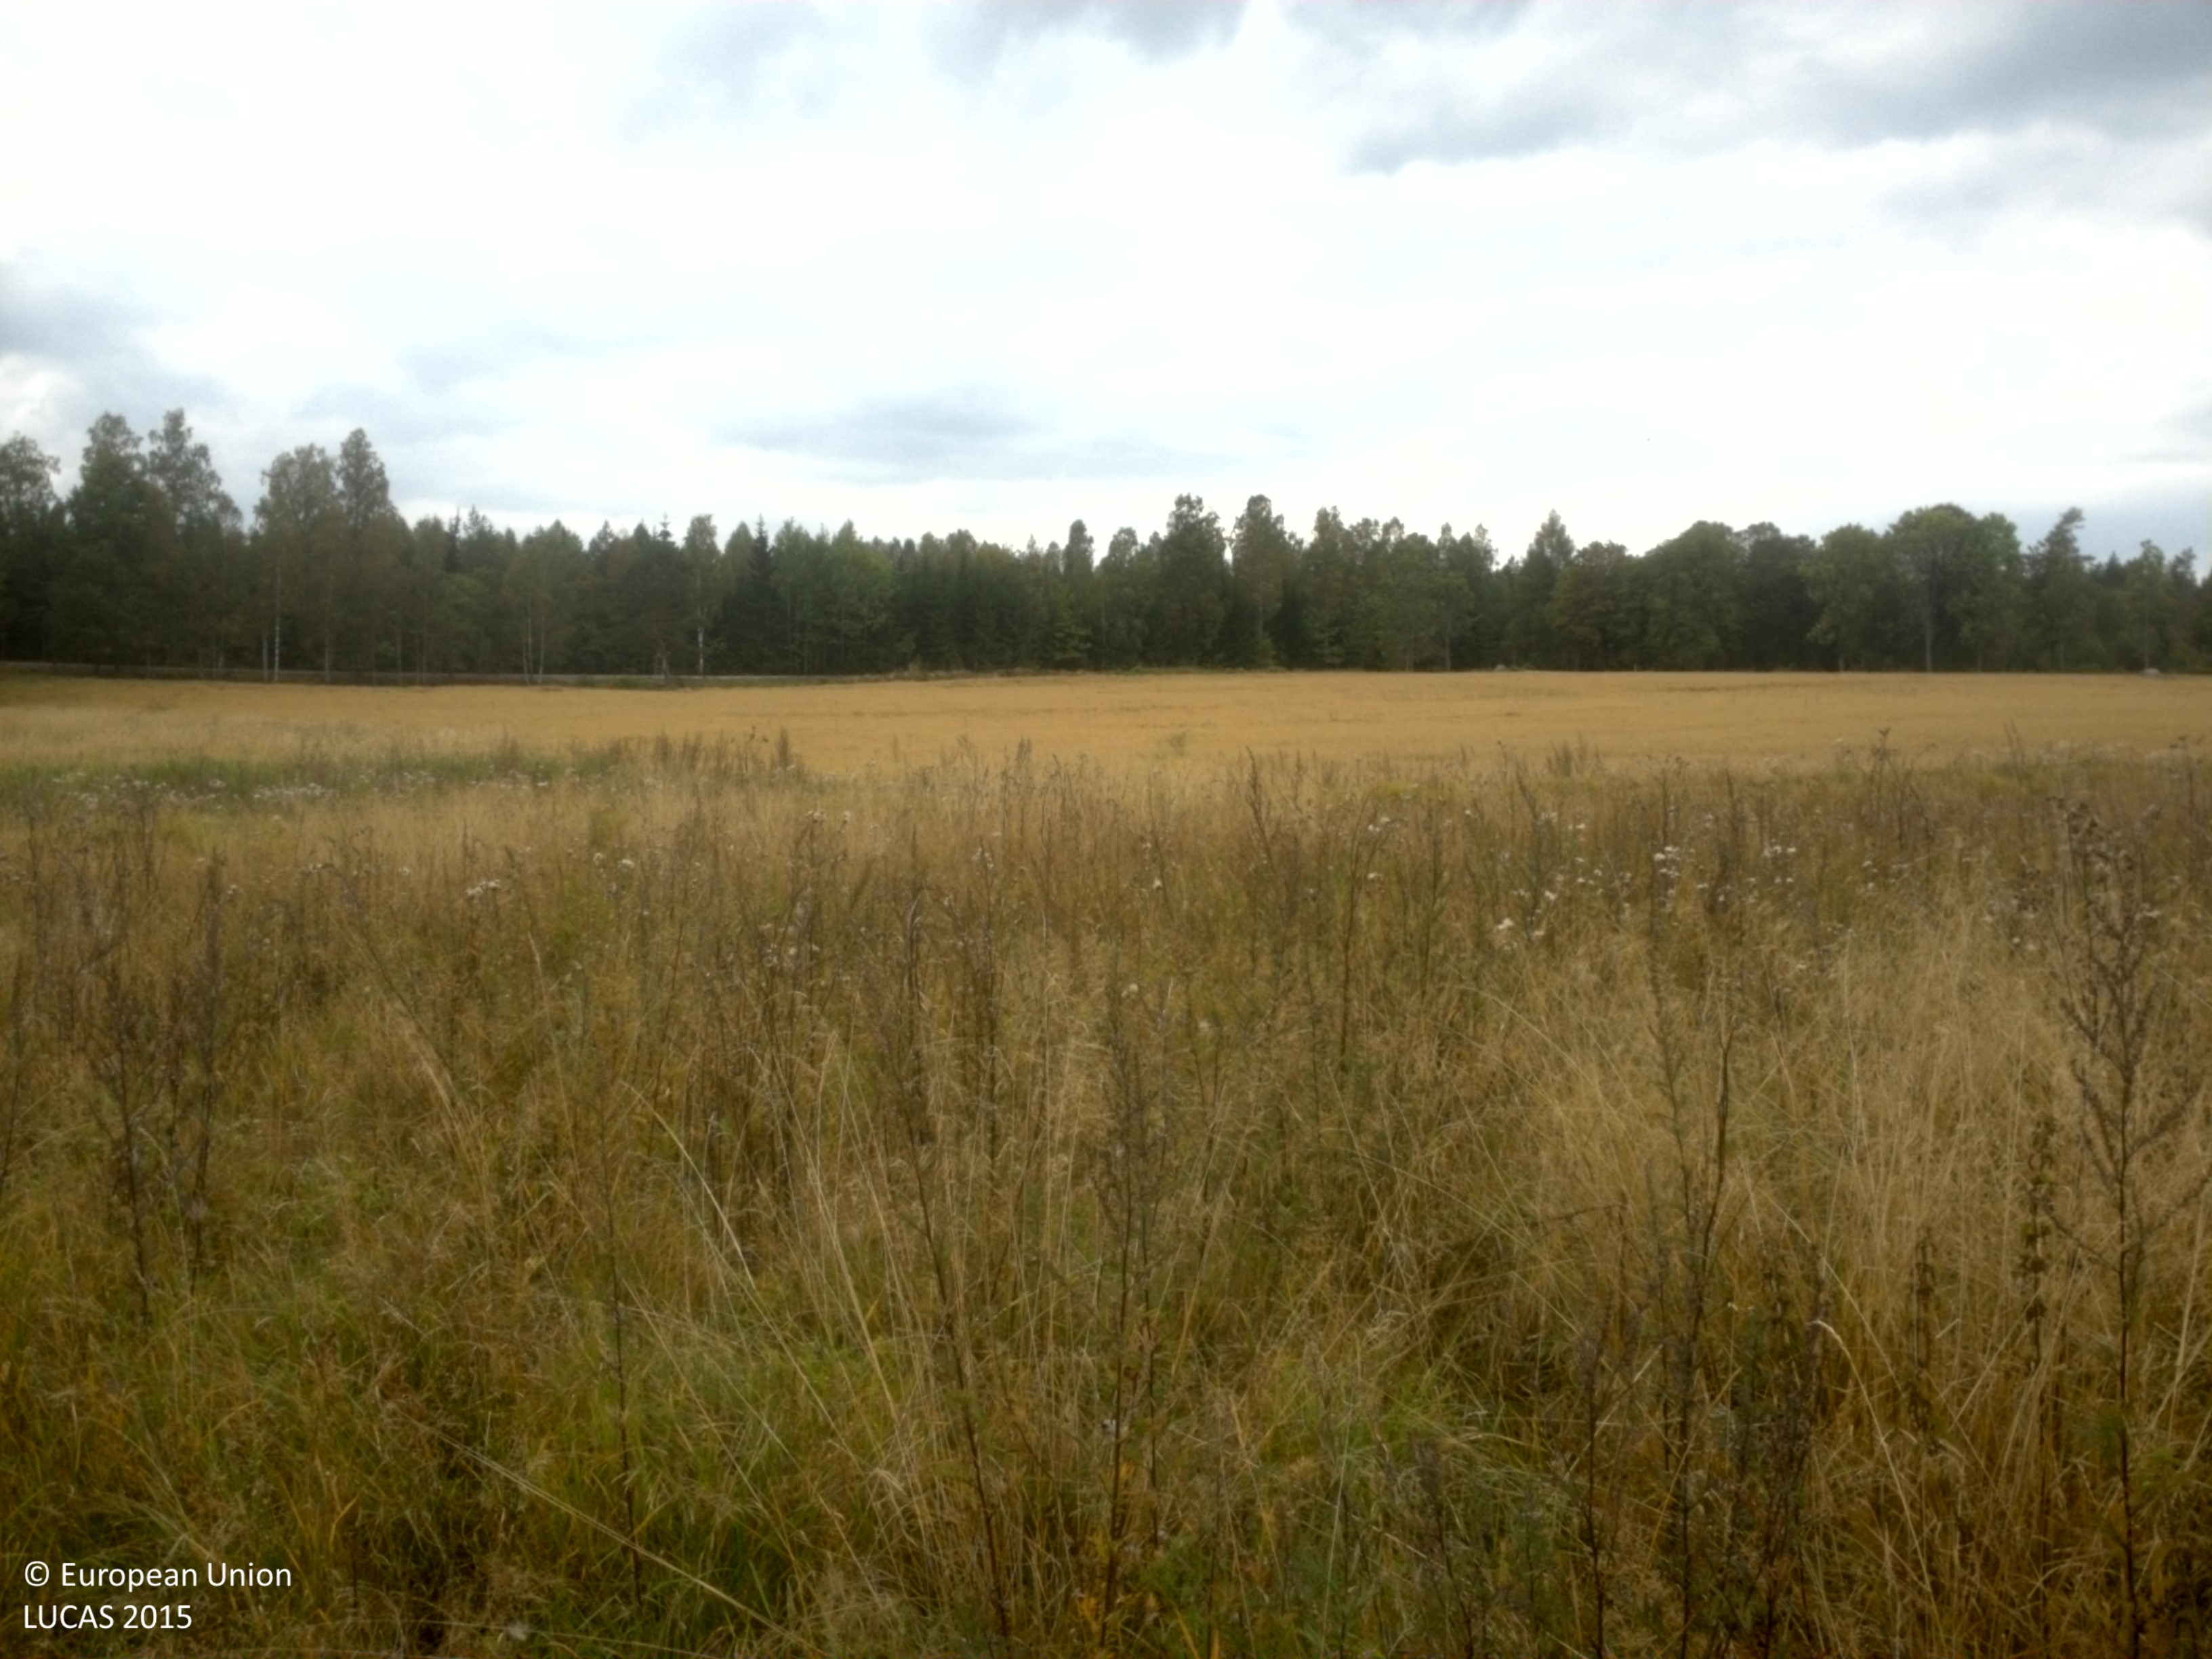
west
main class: Grassland
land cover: Spontaneously vegetated surfaces
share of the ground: > 75 %
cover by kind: herbaceous plants 100 %
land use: Agriculture (excluding fallow land and kitchen gardens)
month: September
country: SE
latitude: 59.5697
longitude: 15.4604
